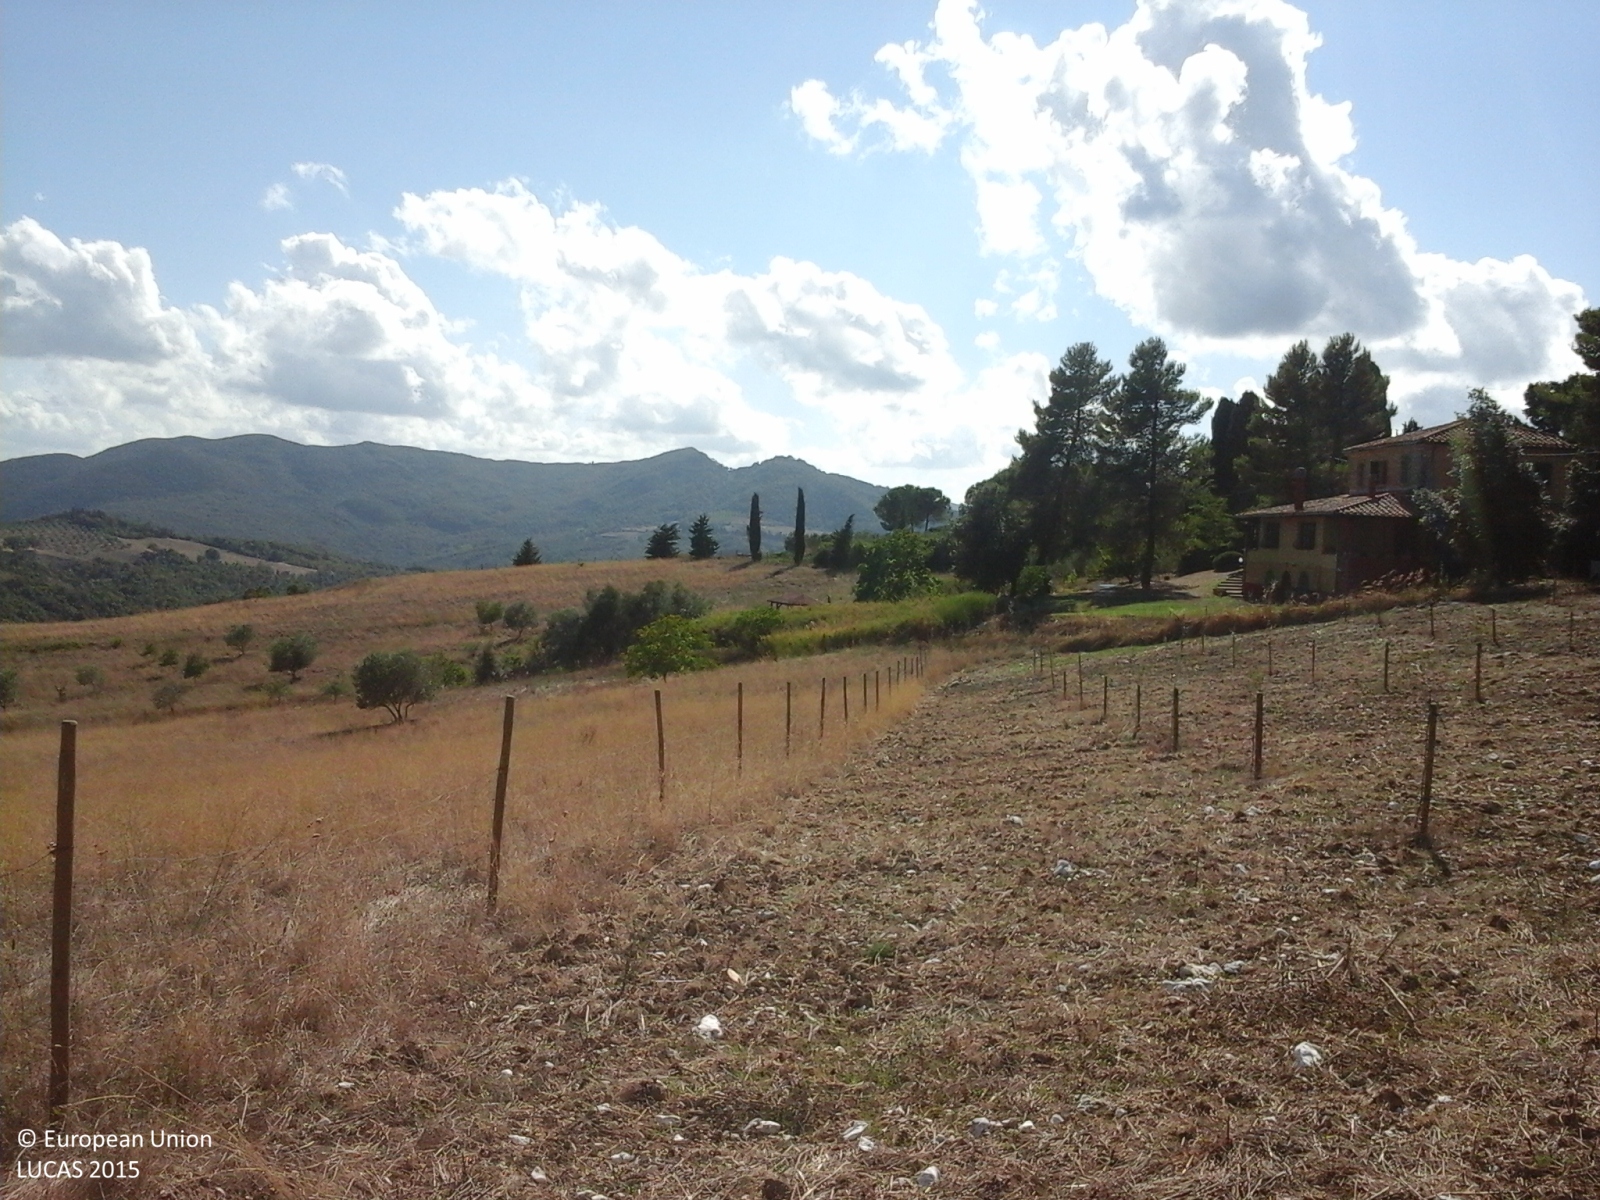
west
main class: Grassland
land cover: Grassland without tree/shrub cover
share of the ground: > 75 %
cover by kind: herbaceous plants 100 %
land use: Agriculture (excluding fallow land and kitchen gardens)
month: August
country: IT
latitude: 43.3005
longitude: 10.8481
